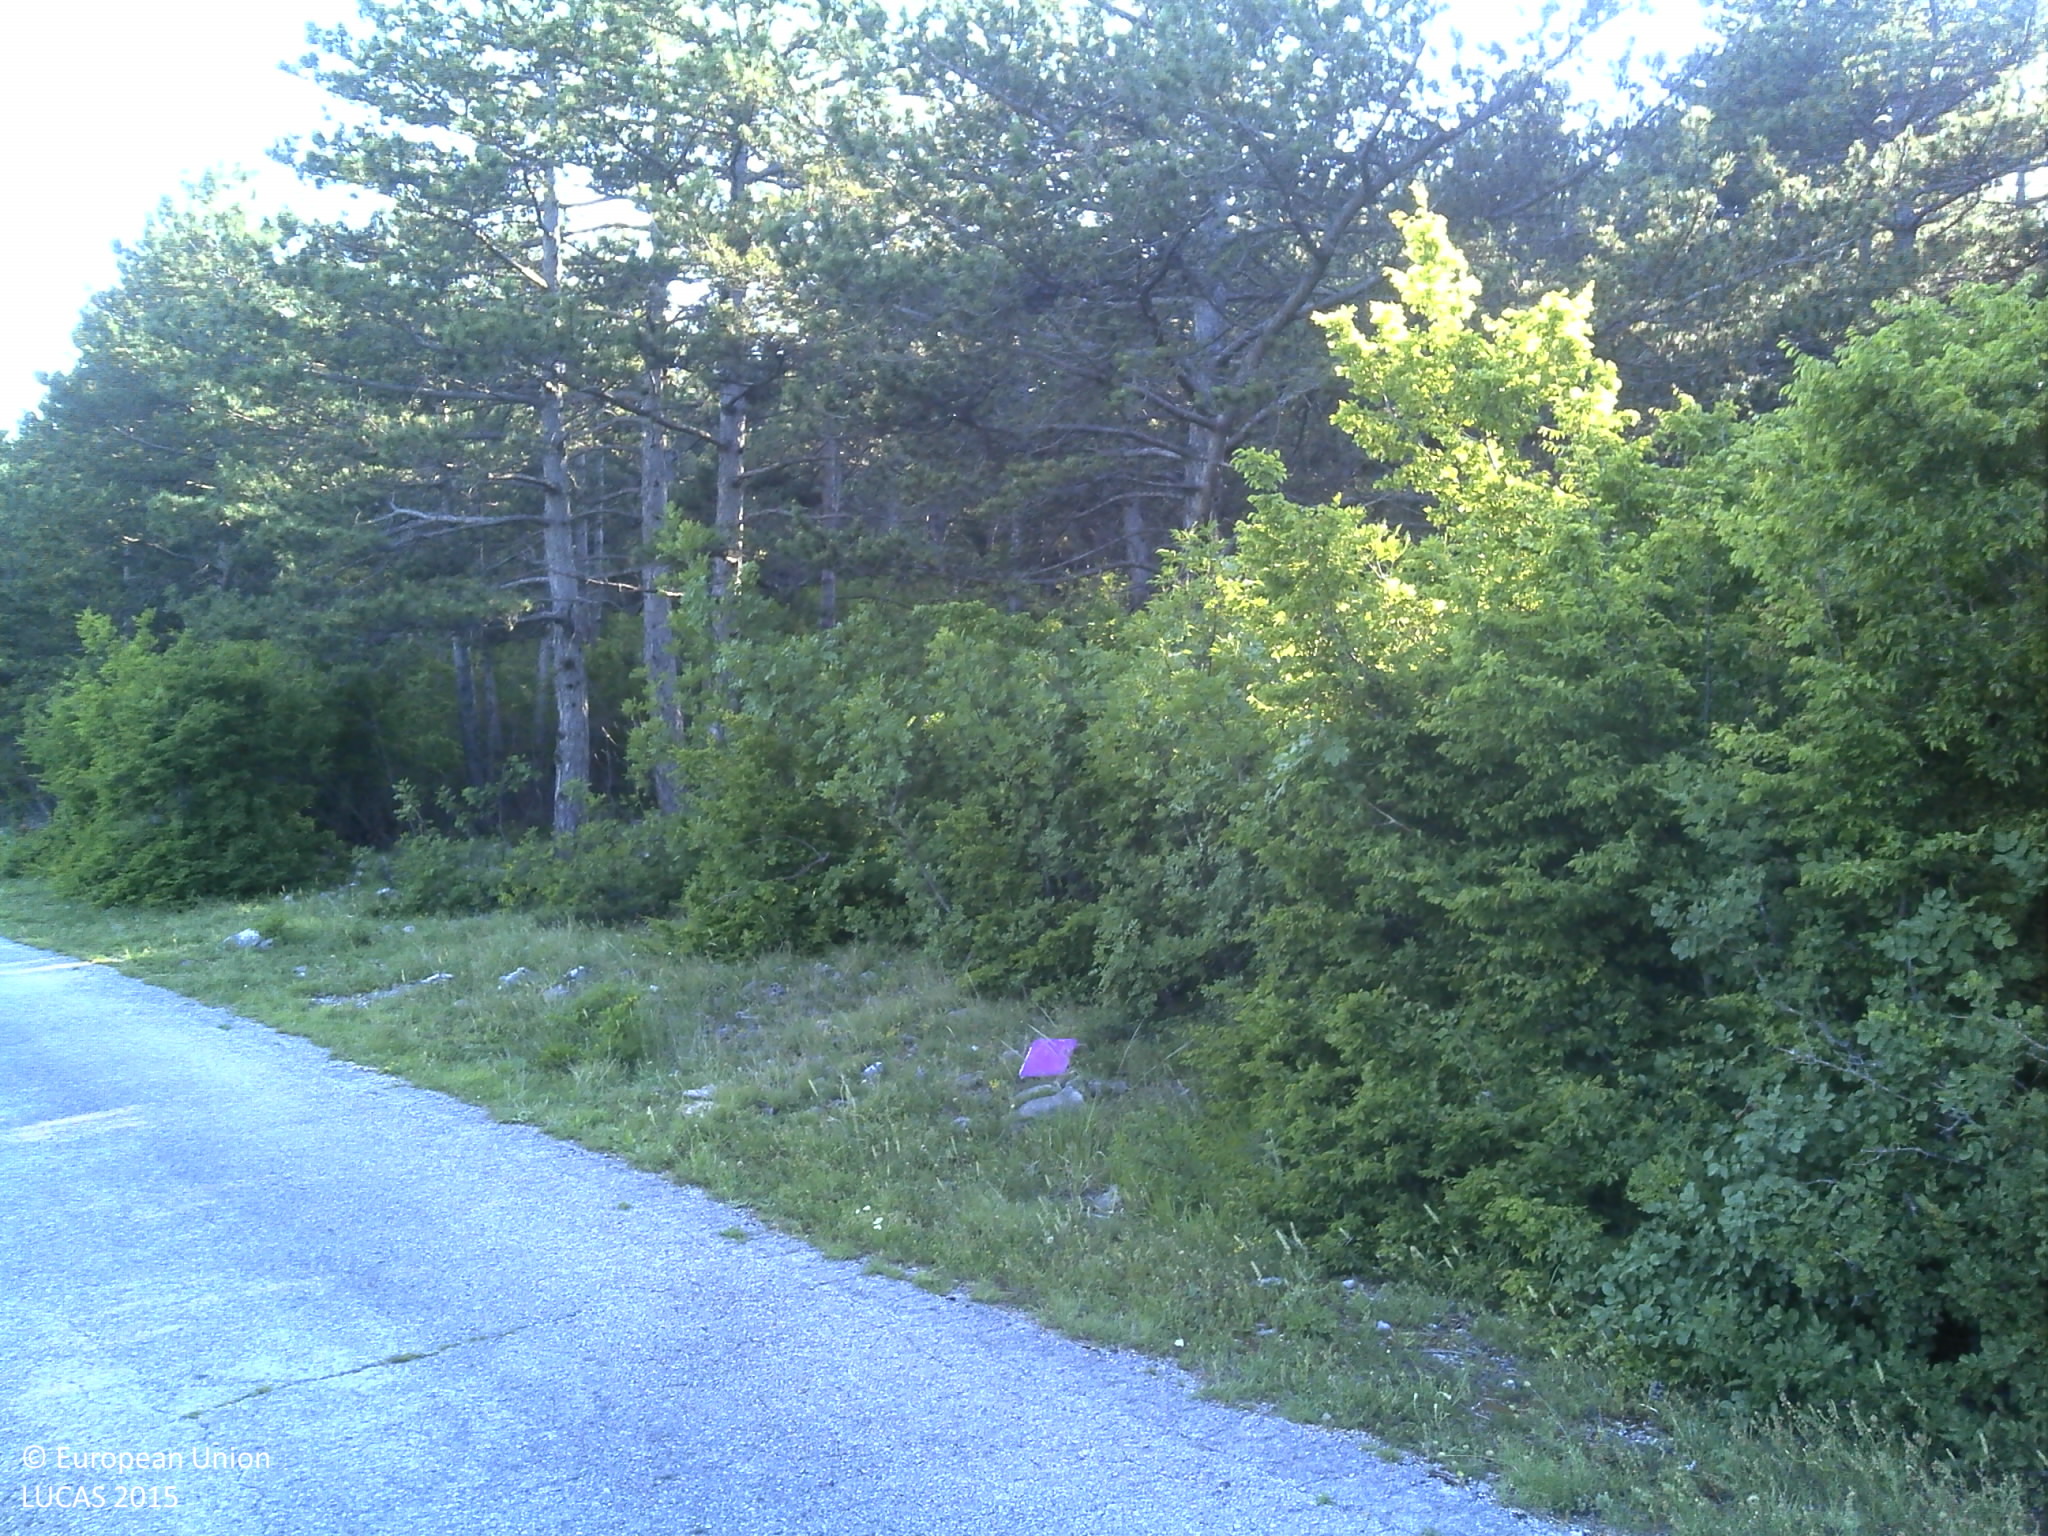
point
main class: Woodland
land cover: Pine dominated coniferous woodland
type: coniferous forest of the mediterranean region
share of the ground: > 75 %
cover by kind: coniferous forest trees 90 %, shrubs 5 %, herbaceous plants 5 %
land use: Forestry
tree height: > 5 m
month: June
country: HR
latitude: 43.9713
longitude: 16.4120
